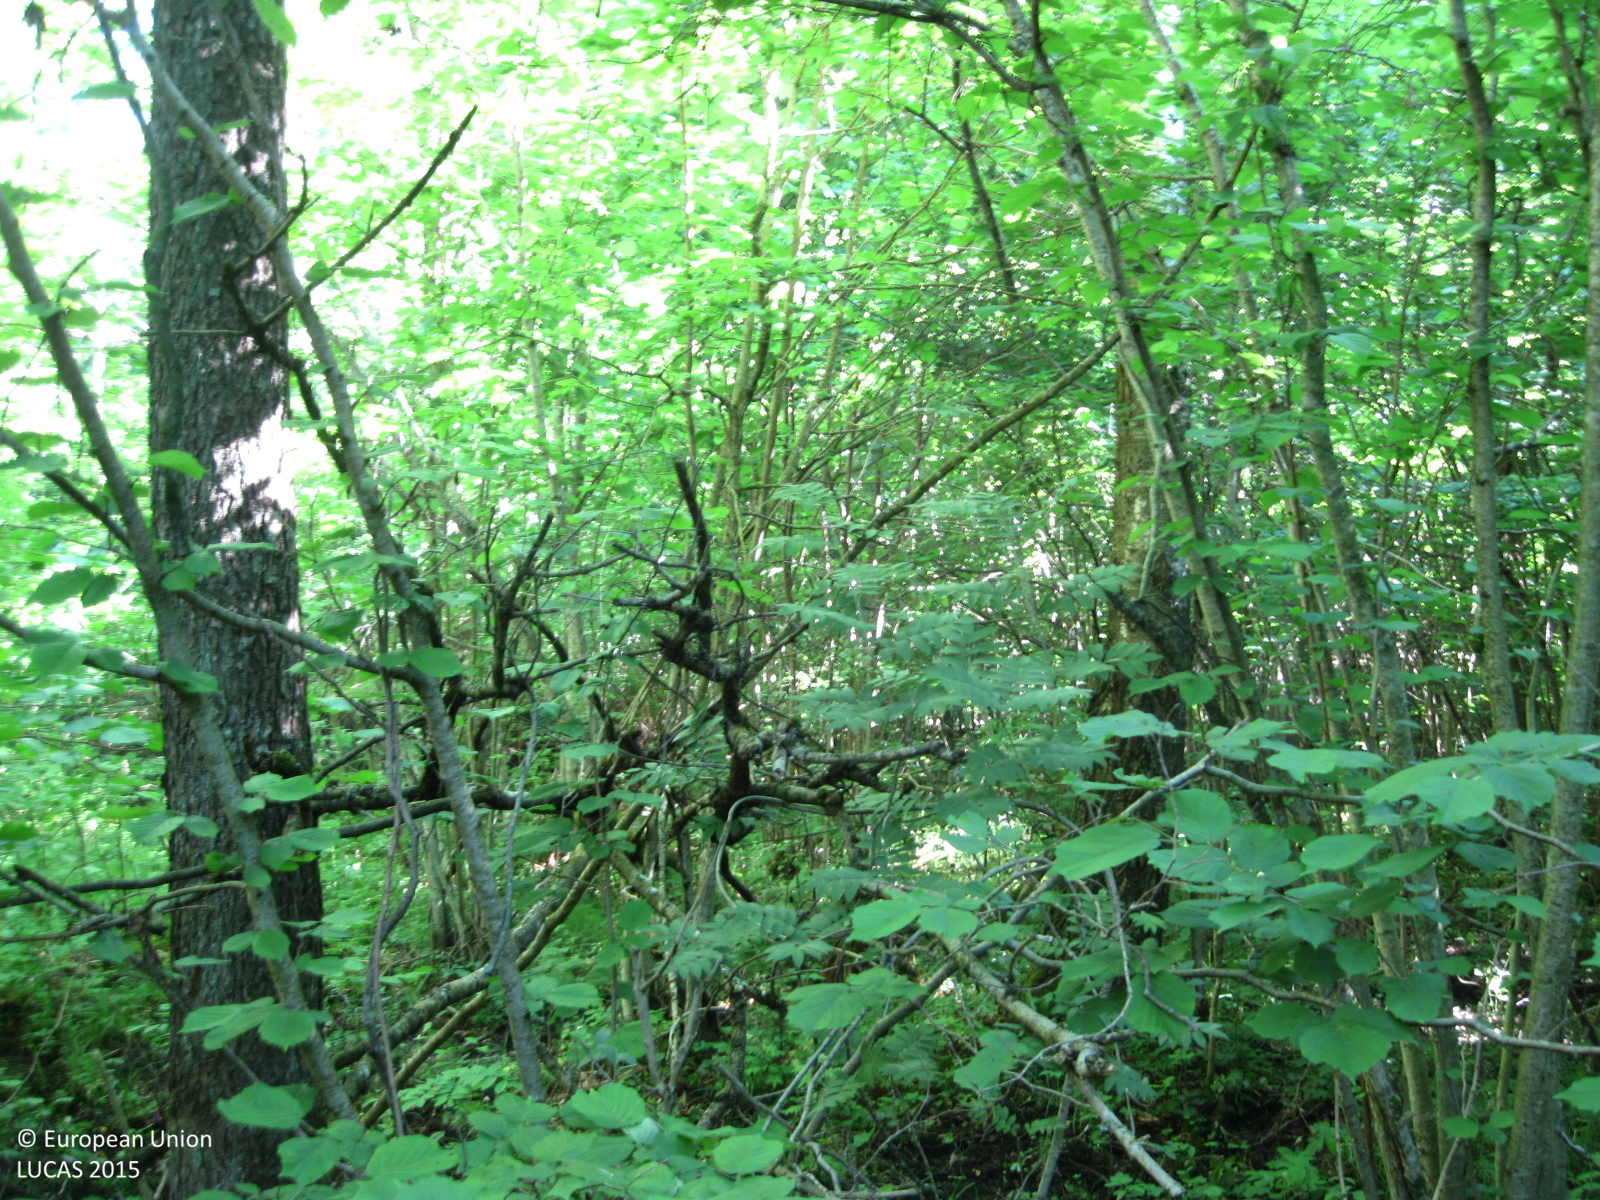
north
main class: Woodland
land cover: Spruce dominated mixed woodland
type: hemiboreal forest and nemoral coniferous forest and mixed broadleaved-coniferous forest
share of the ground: > 75 %
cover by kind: broadleaved forest trees 45 %, coniferous forest trees 35 %, herbaceous plants 20 %
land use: Forestry
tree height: > 5 m
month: June
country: LT
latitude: 55.3295
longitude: 23.7829
